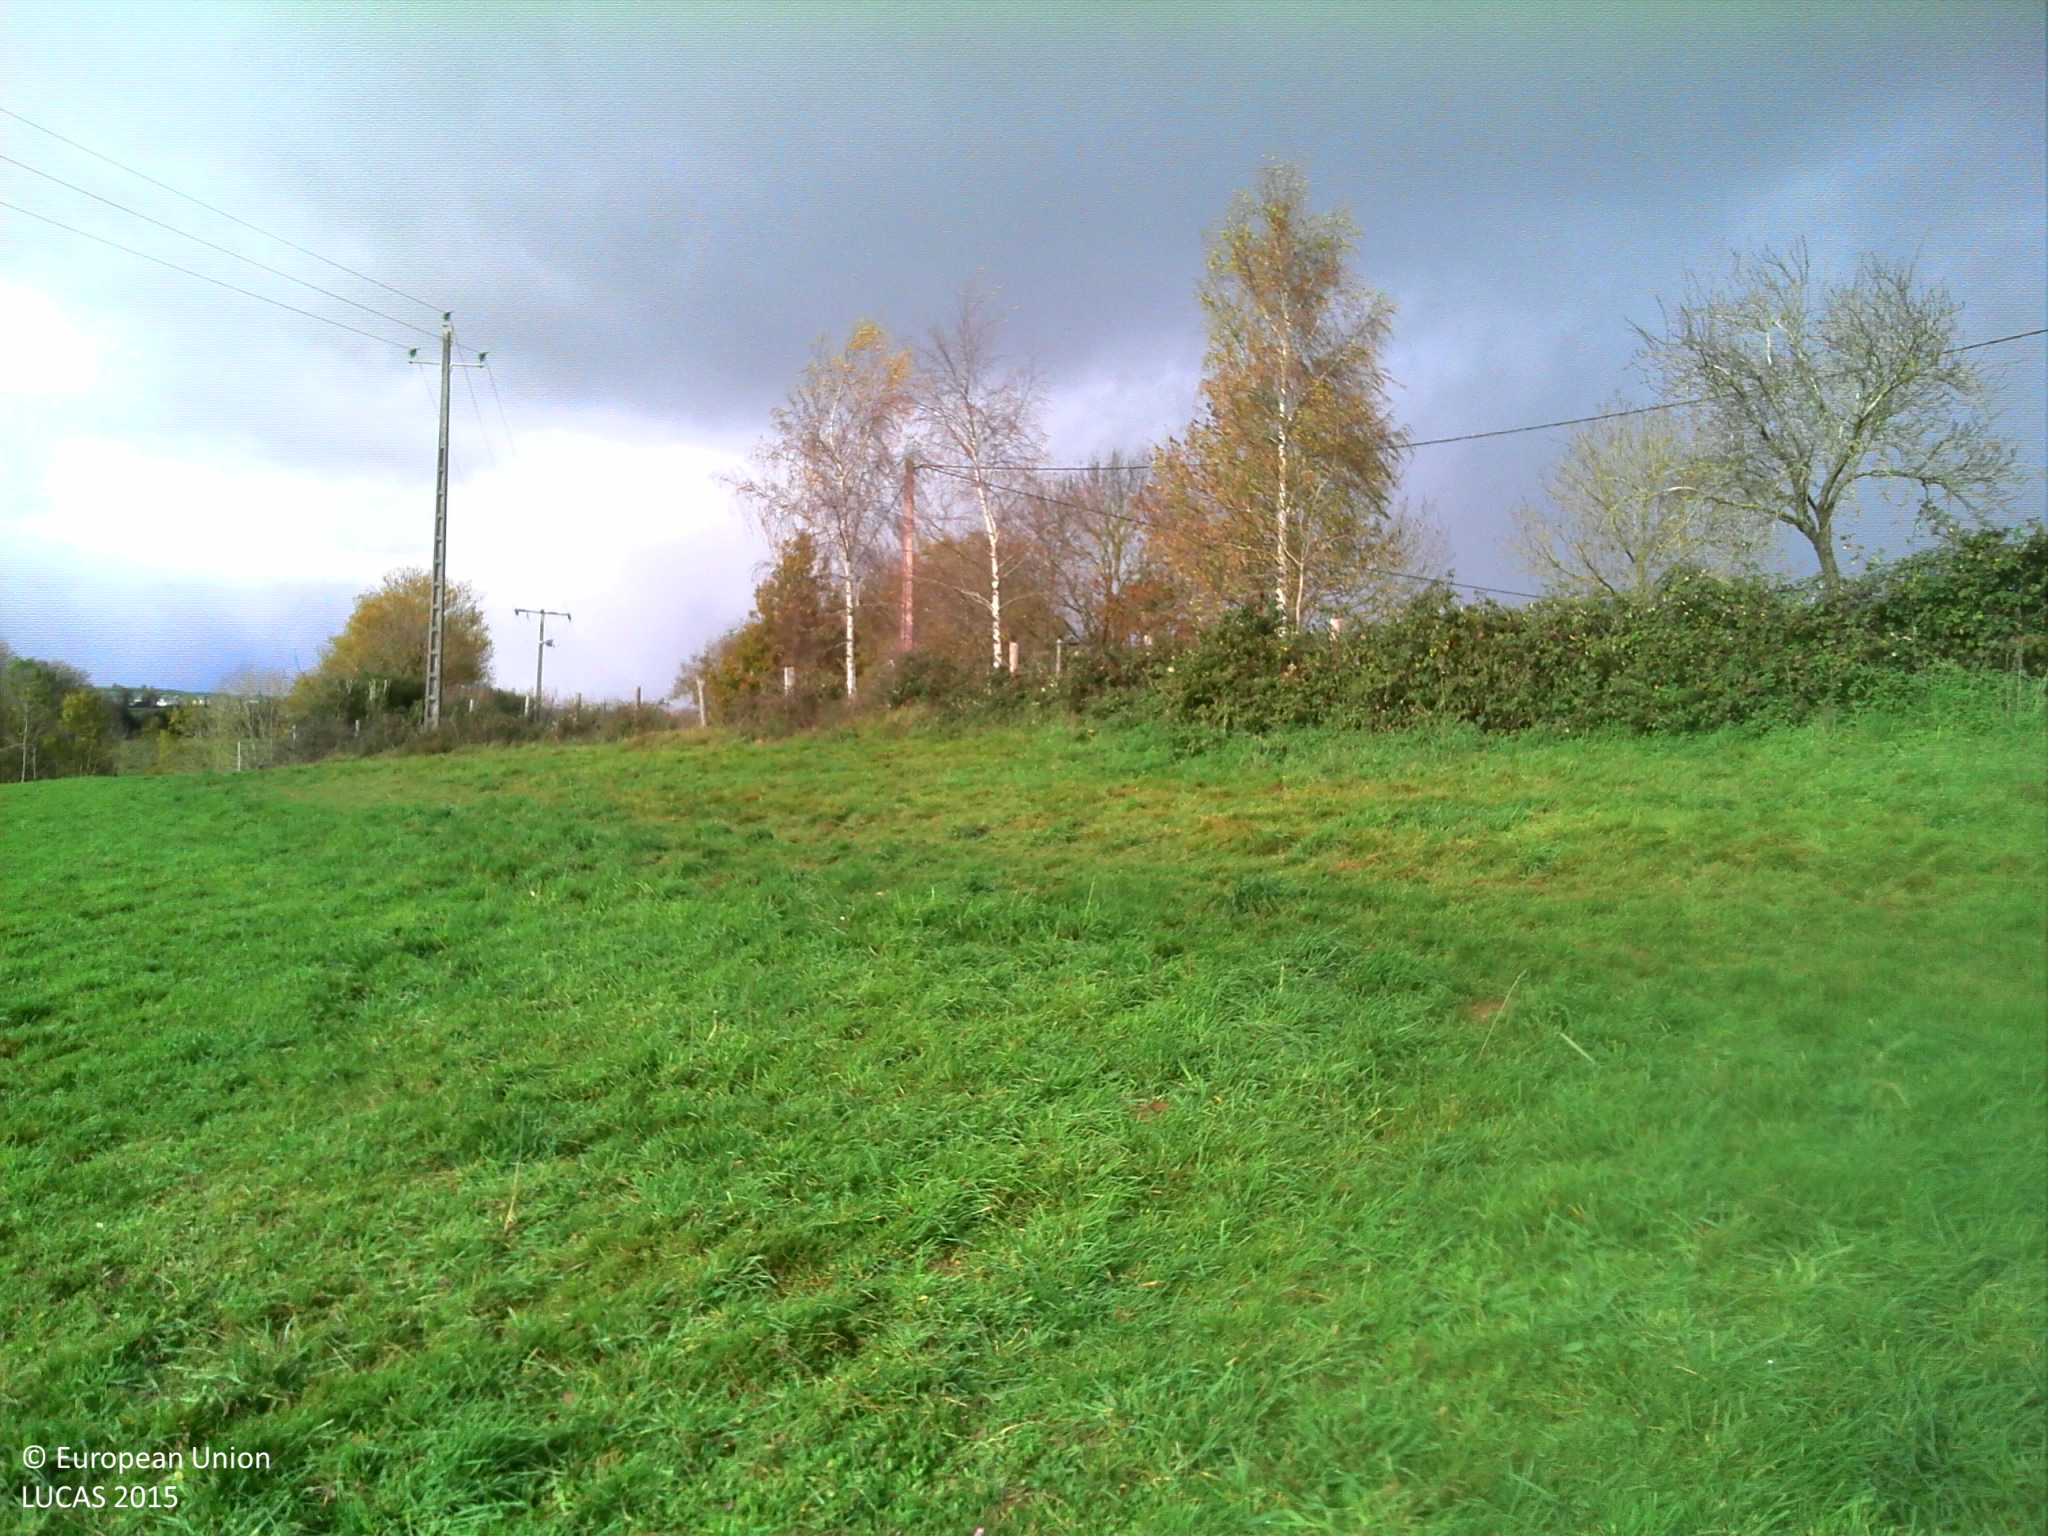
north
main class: Grassland
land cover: Grassland without tree/shrub cover
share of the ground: > 75 %
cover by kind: herbaceous plants 100 %
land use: Agriculture (excluding fallow land and kitchen gardens)
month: November
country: FR
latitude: 44.0681
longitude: 2.6010
